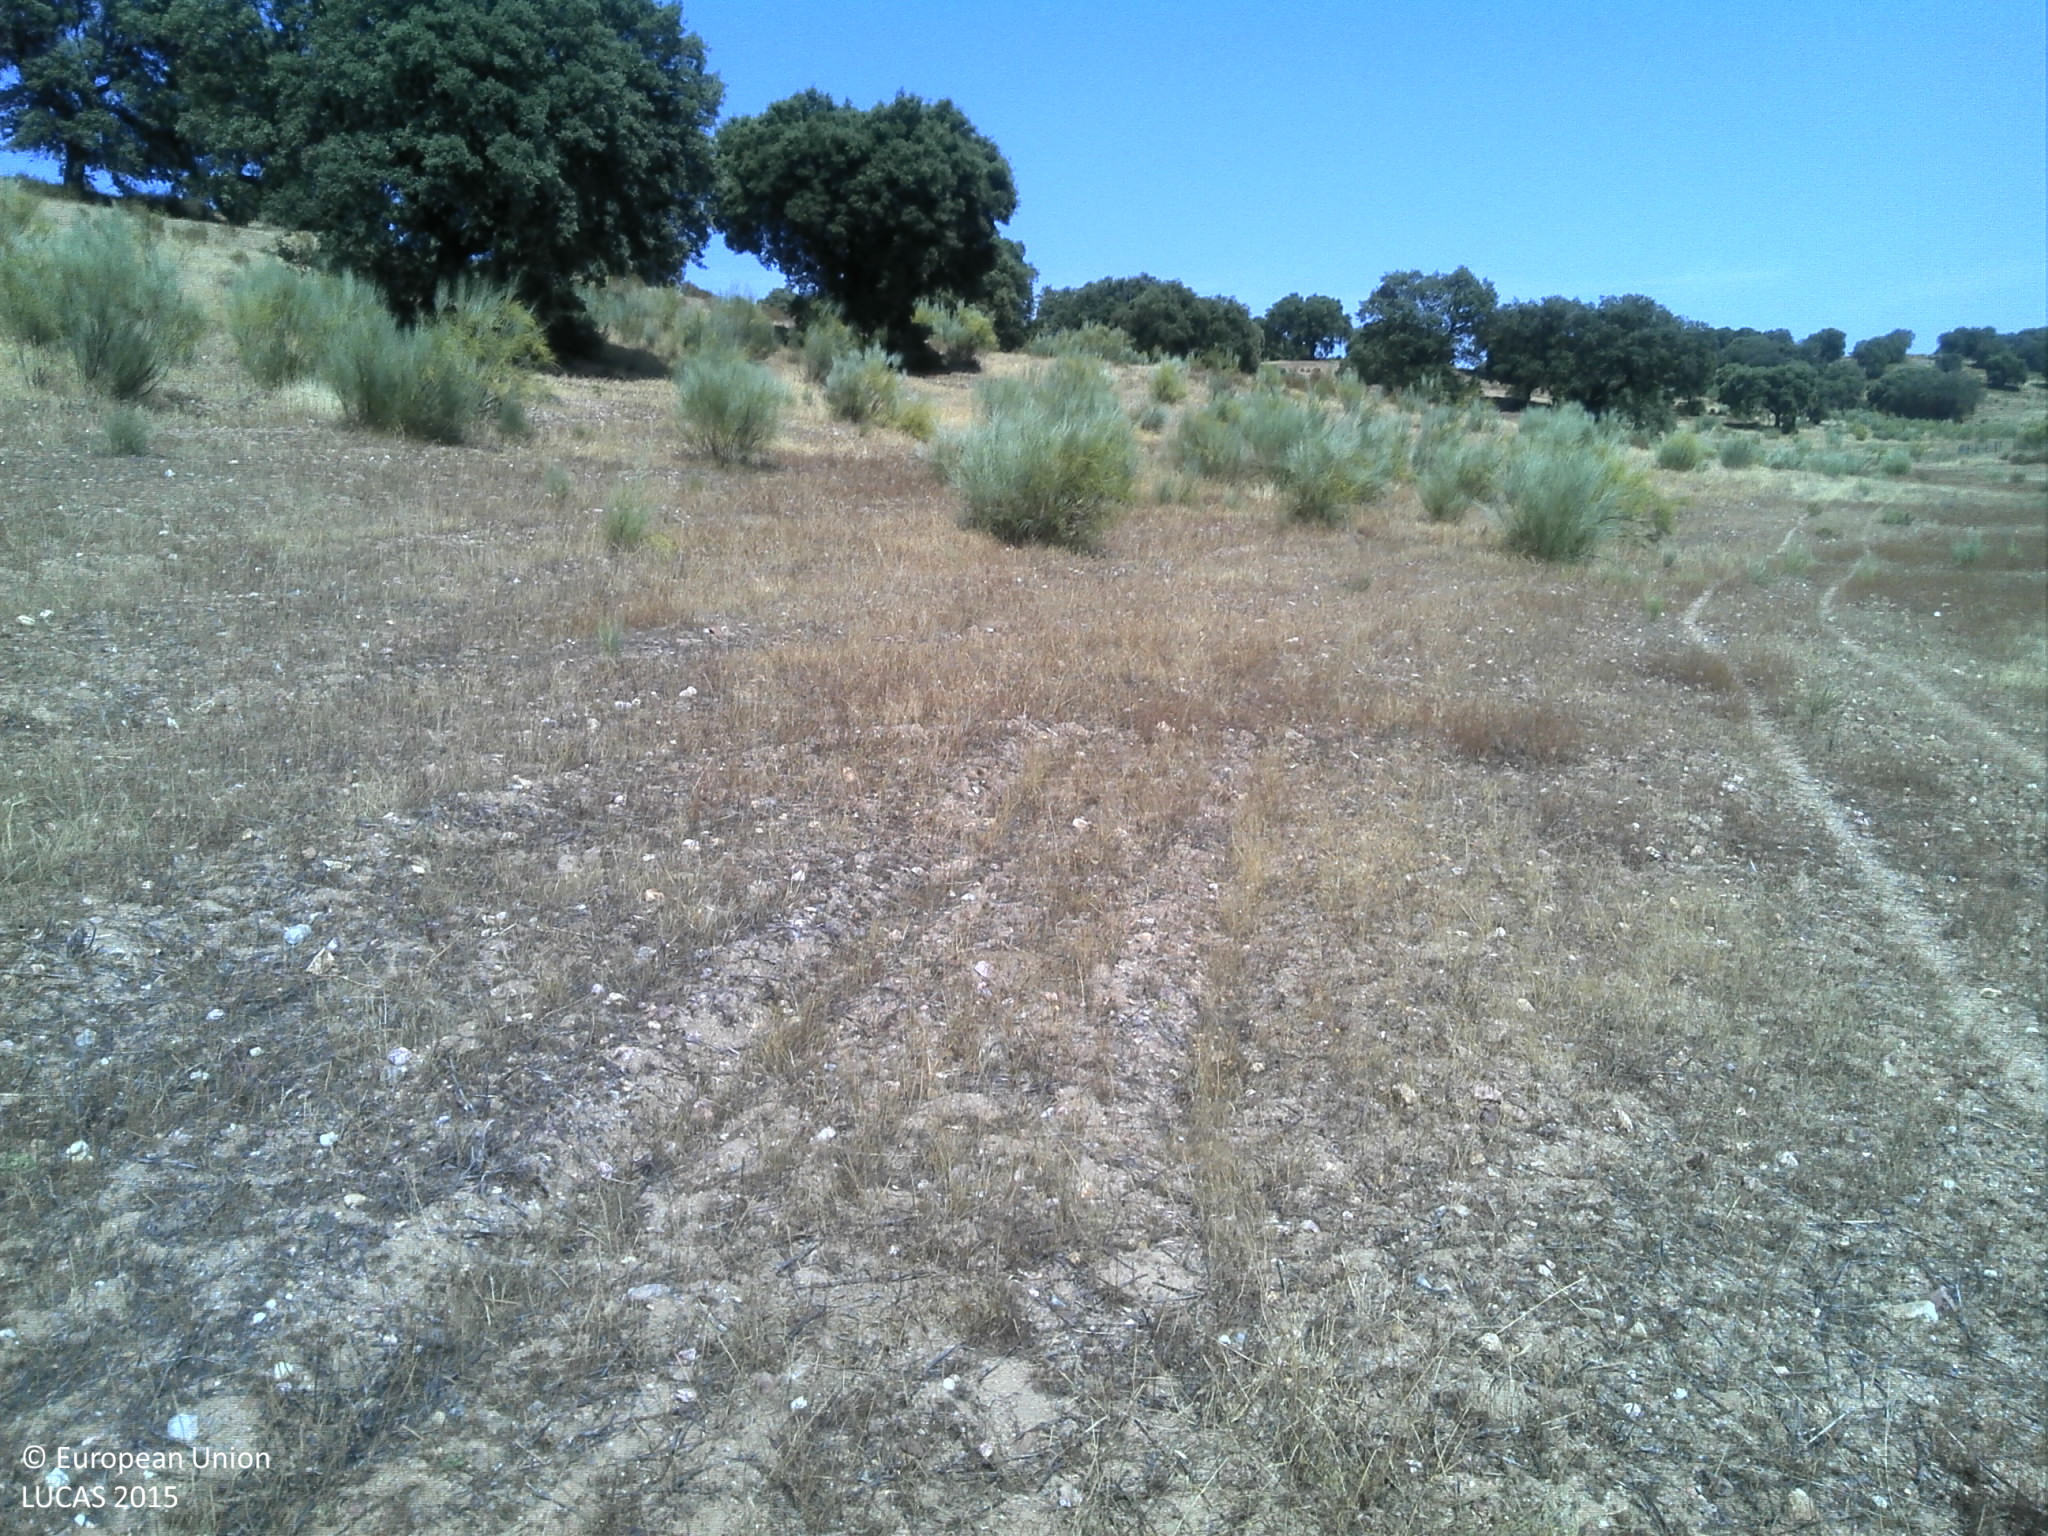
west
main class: Grassland
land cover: Grassland without tree/shrub cover
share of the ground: 10 - 25 %
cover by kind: unconsolidated bare surface 75 %, herbaceous plants 25 %
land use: Agriculture (excluding fallow land and kitchen gardens)
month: June
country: PT
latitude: 39.7683
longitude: -7.0976
